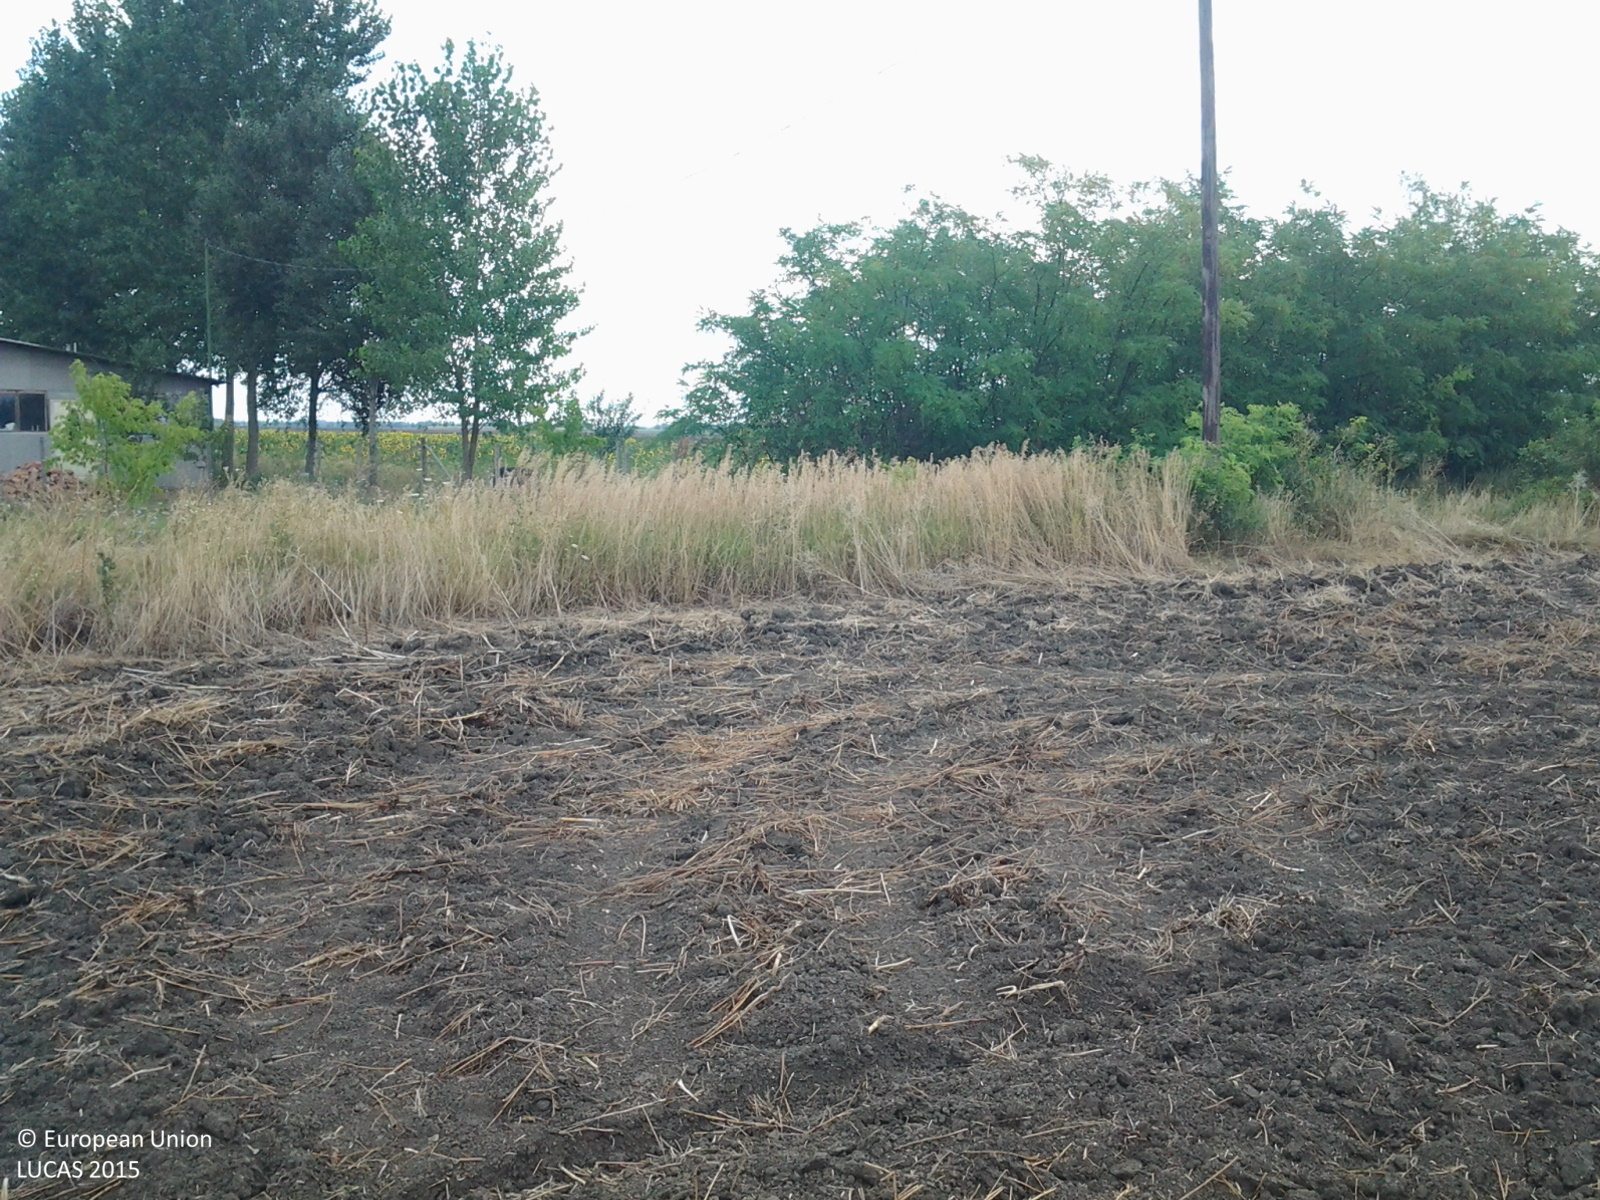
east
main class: Cropland
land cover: Rape and turnip rape
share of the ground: < 10 %
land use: Agriculture (excluding fallow land and kitchen gardens)
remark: Harvested field
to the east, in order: Rape and turnip rape; Grass margins; Electric lines; Grass margins; Tracks; Grass margins; Abandoned hedges; Ditches and canals; Grass margins; Fences; Grassland without tree/shrub cover; Fences; Grass margins; Lines of trees; Grass margins; Sunflower; Tracks; Other bare soil
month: July
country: HU
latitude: 47.1770
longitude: 20.4929
